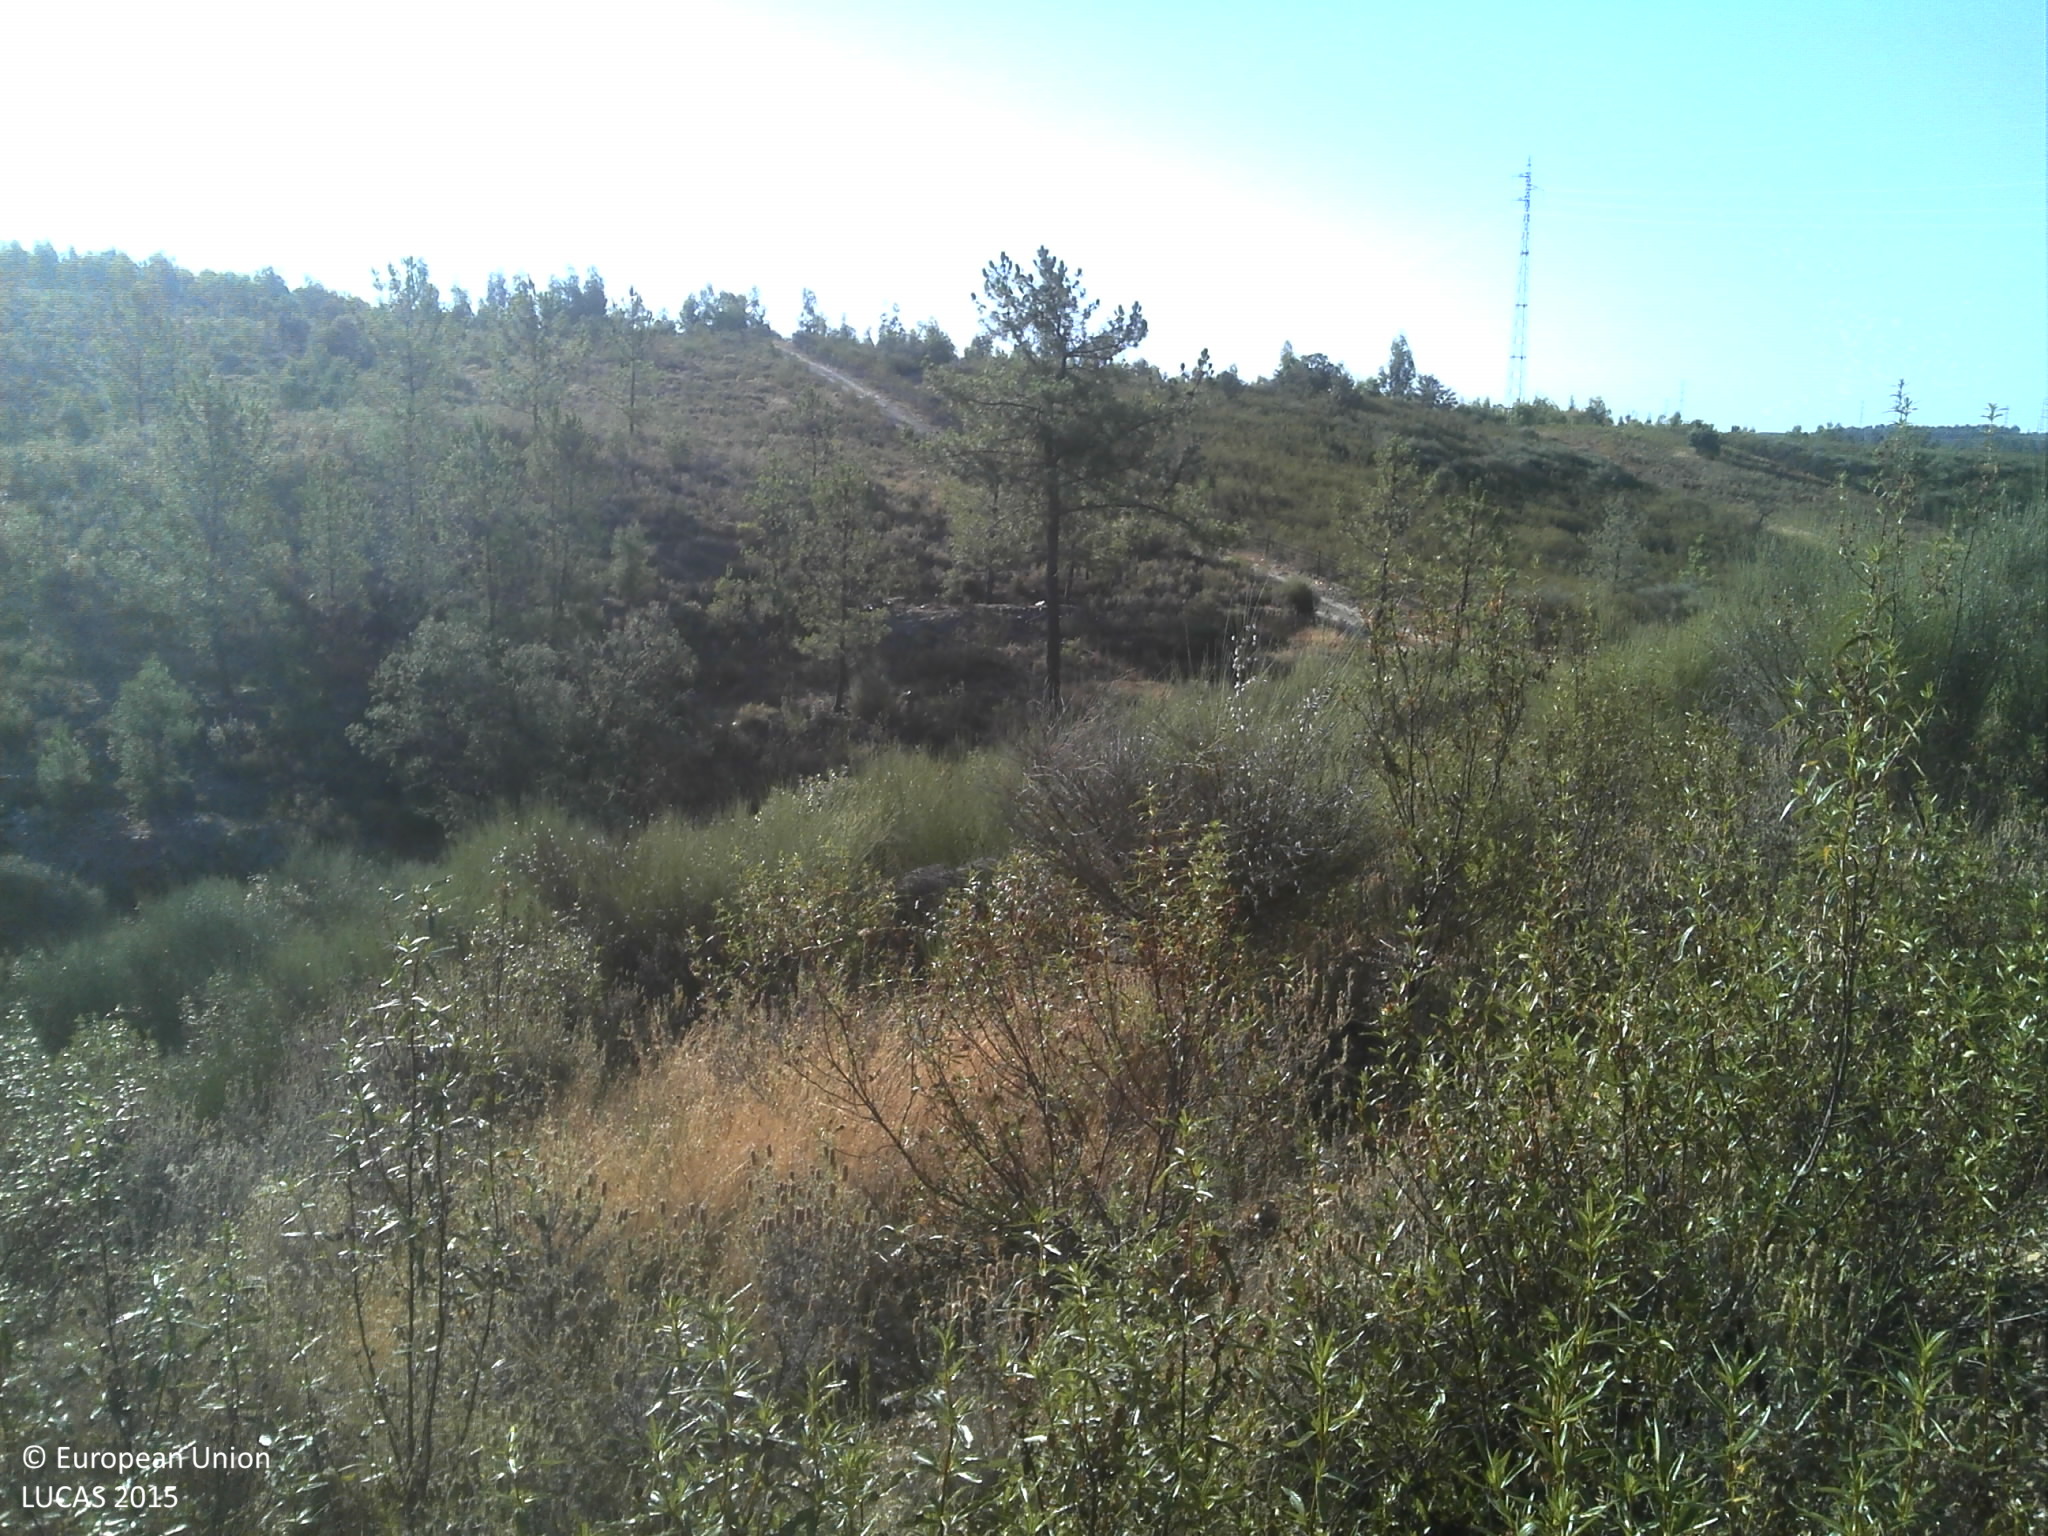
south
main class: Shrubland
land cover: Shrubland without tree cover
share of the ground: 50 - 75 %
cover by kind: shrubs 65 %, unconsolidated bare surface 15 %, herbaceous plants 10 %
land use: Semi-natural and natural areas not in use
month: July
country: PT
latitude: 39.8309
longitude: -7.5694
